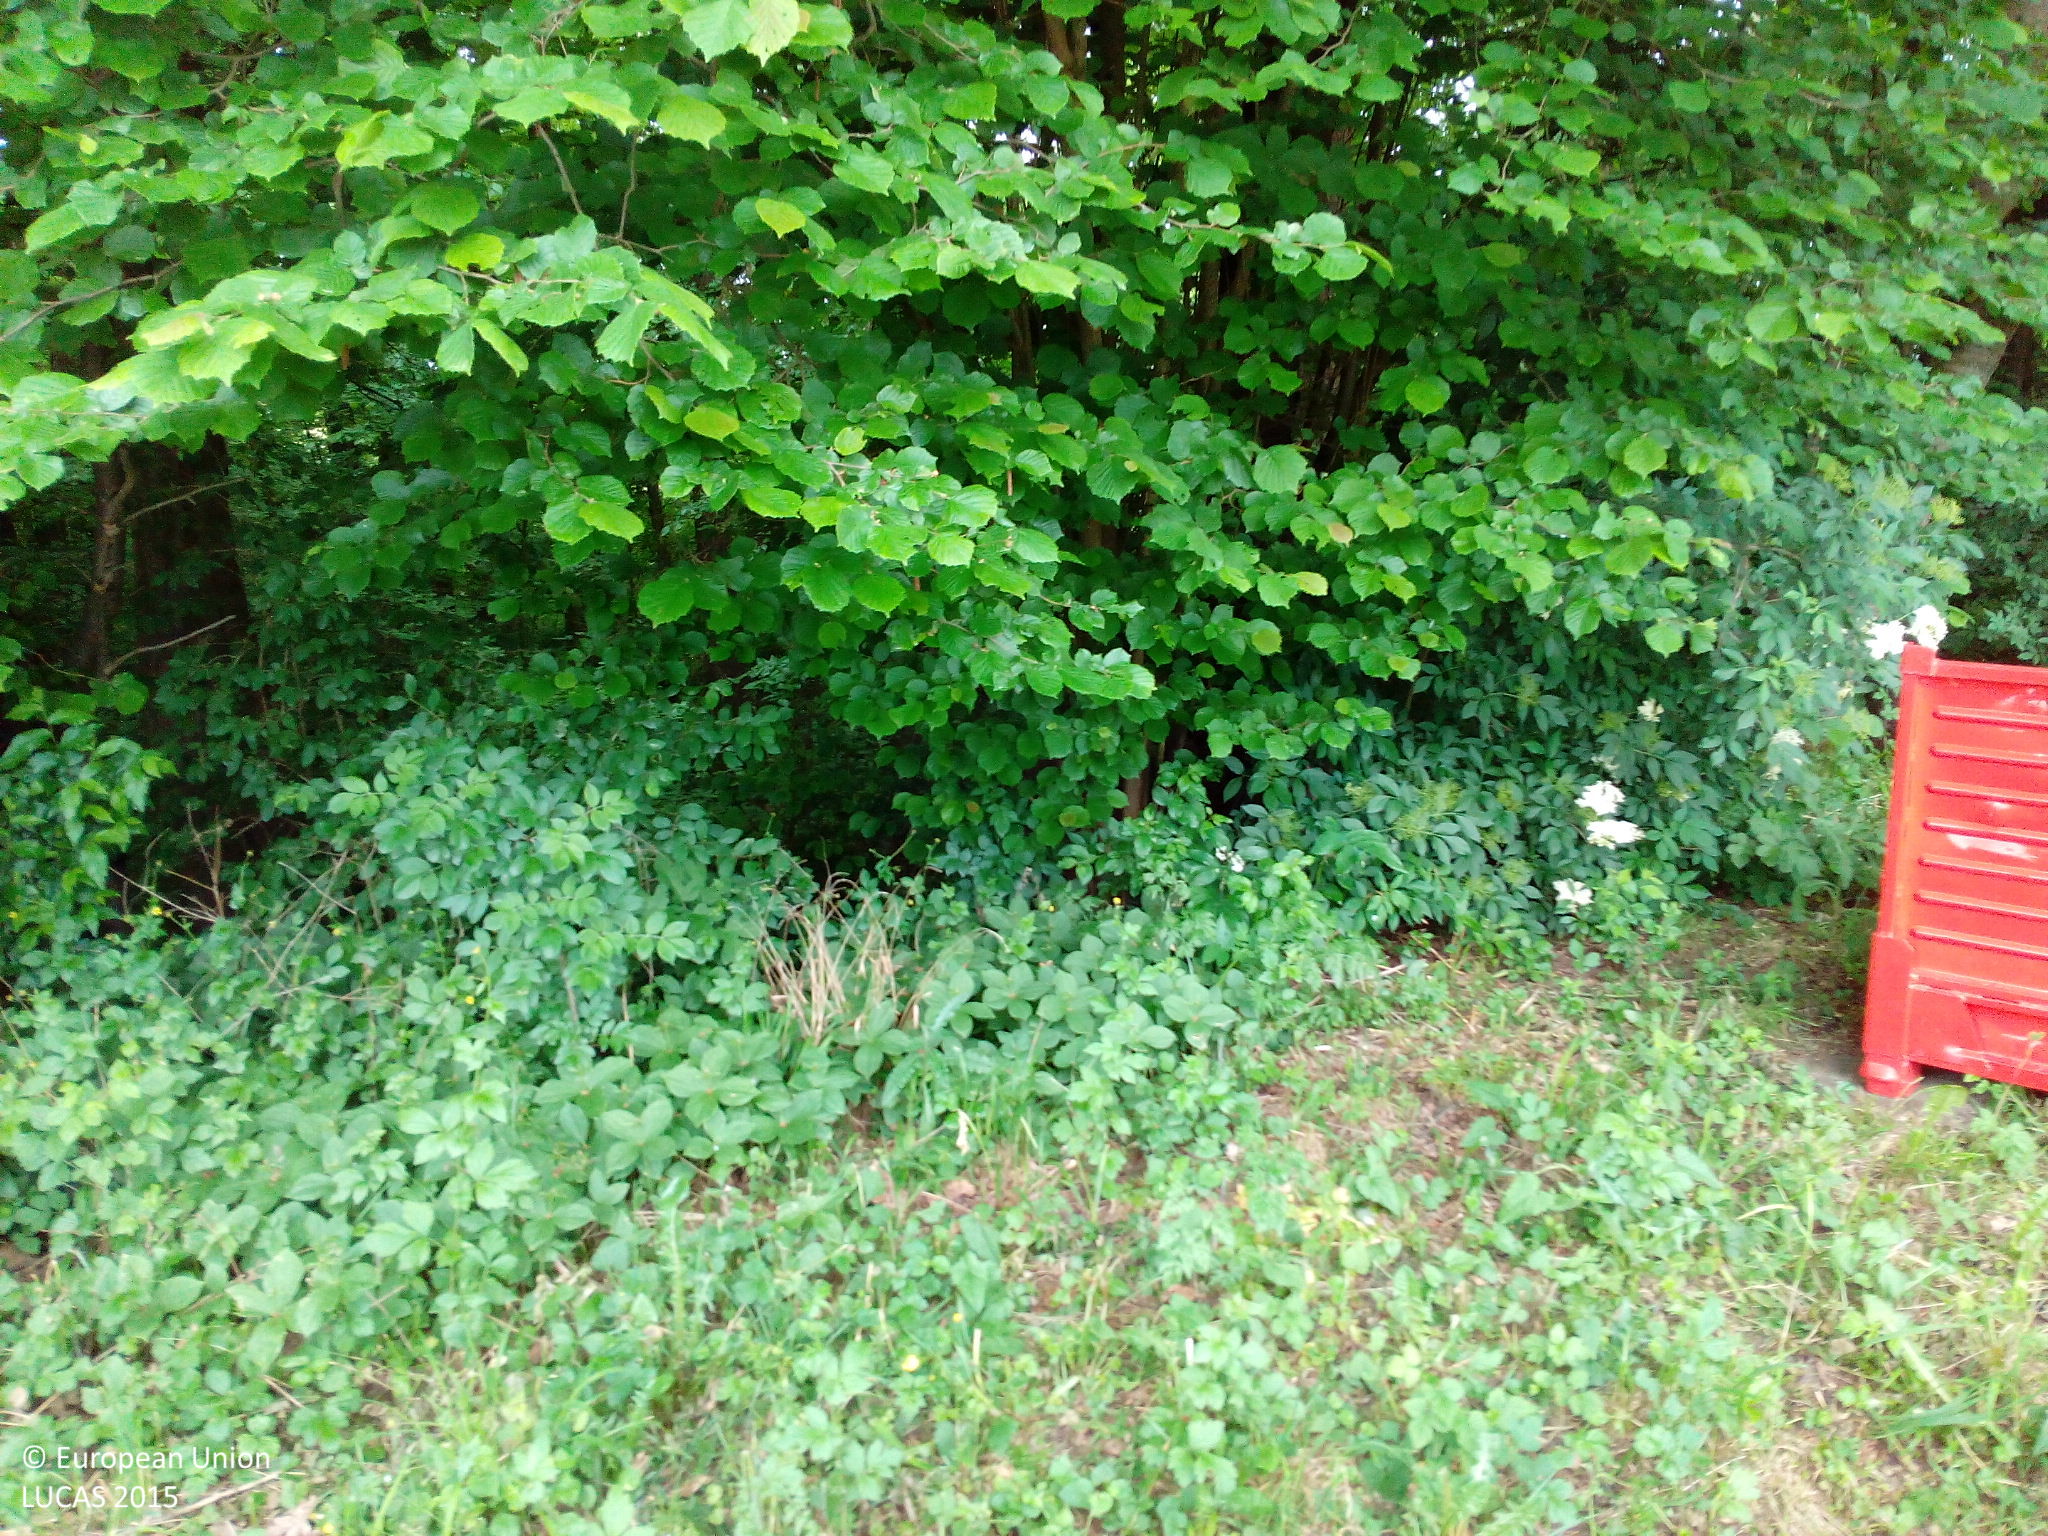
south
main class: Grassland
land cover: Grassland without tree/shrub cover
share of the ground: > 75 %
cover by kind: herbaceous plants 100 %
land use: Agriculture (excluding fallow land and kitchen gardens)
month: June
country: DE
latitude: 50.0367
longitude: 10.9072
